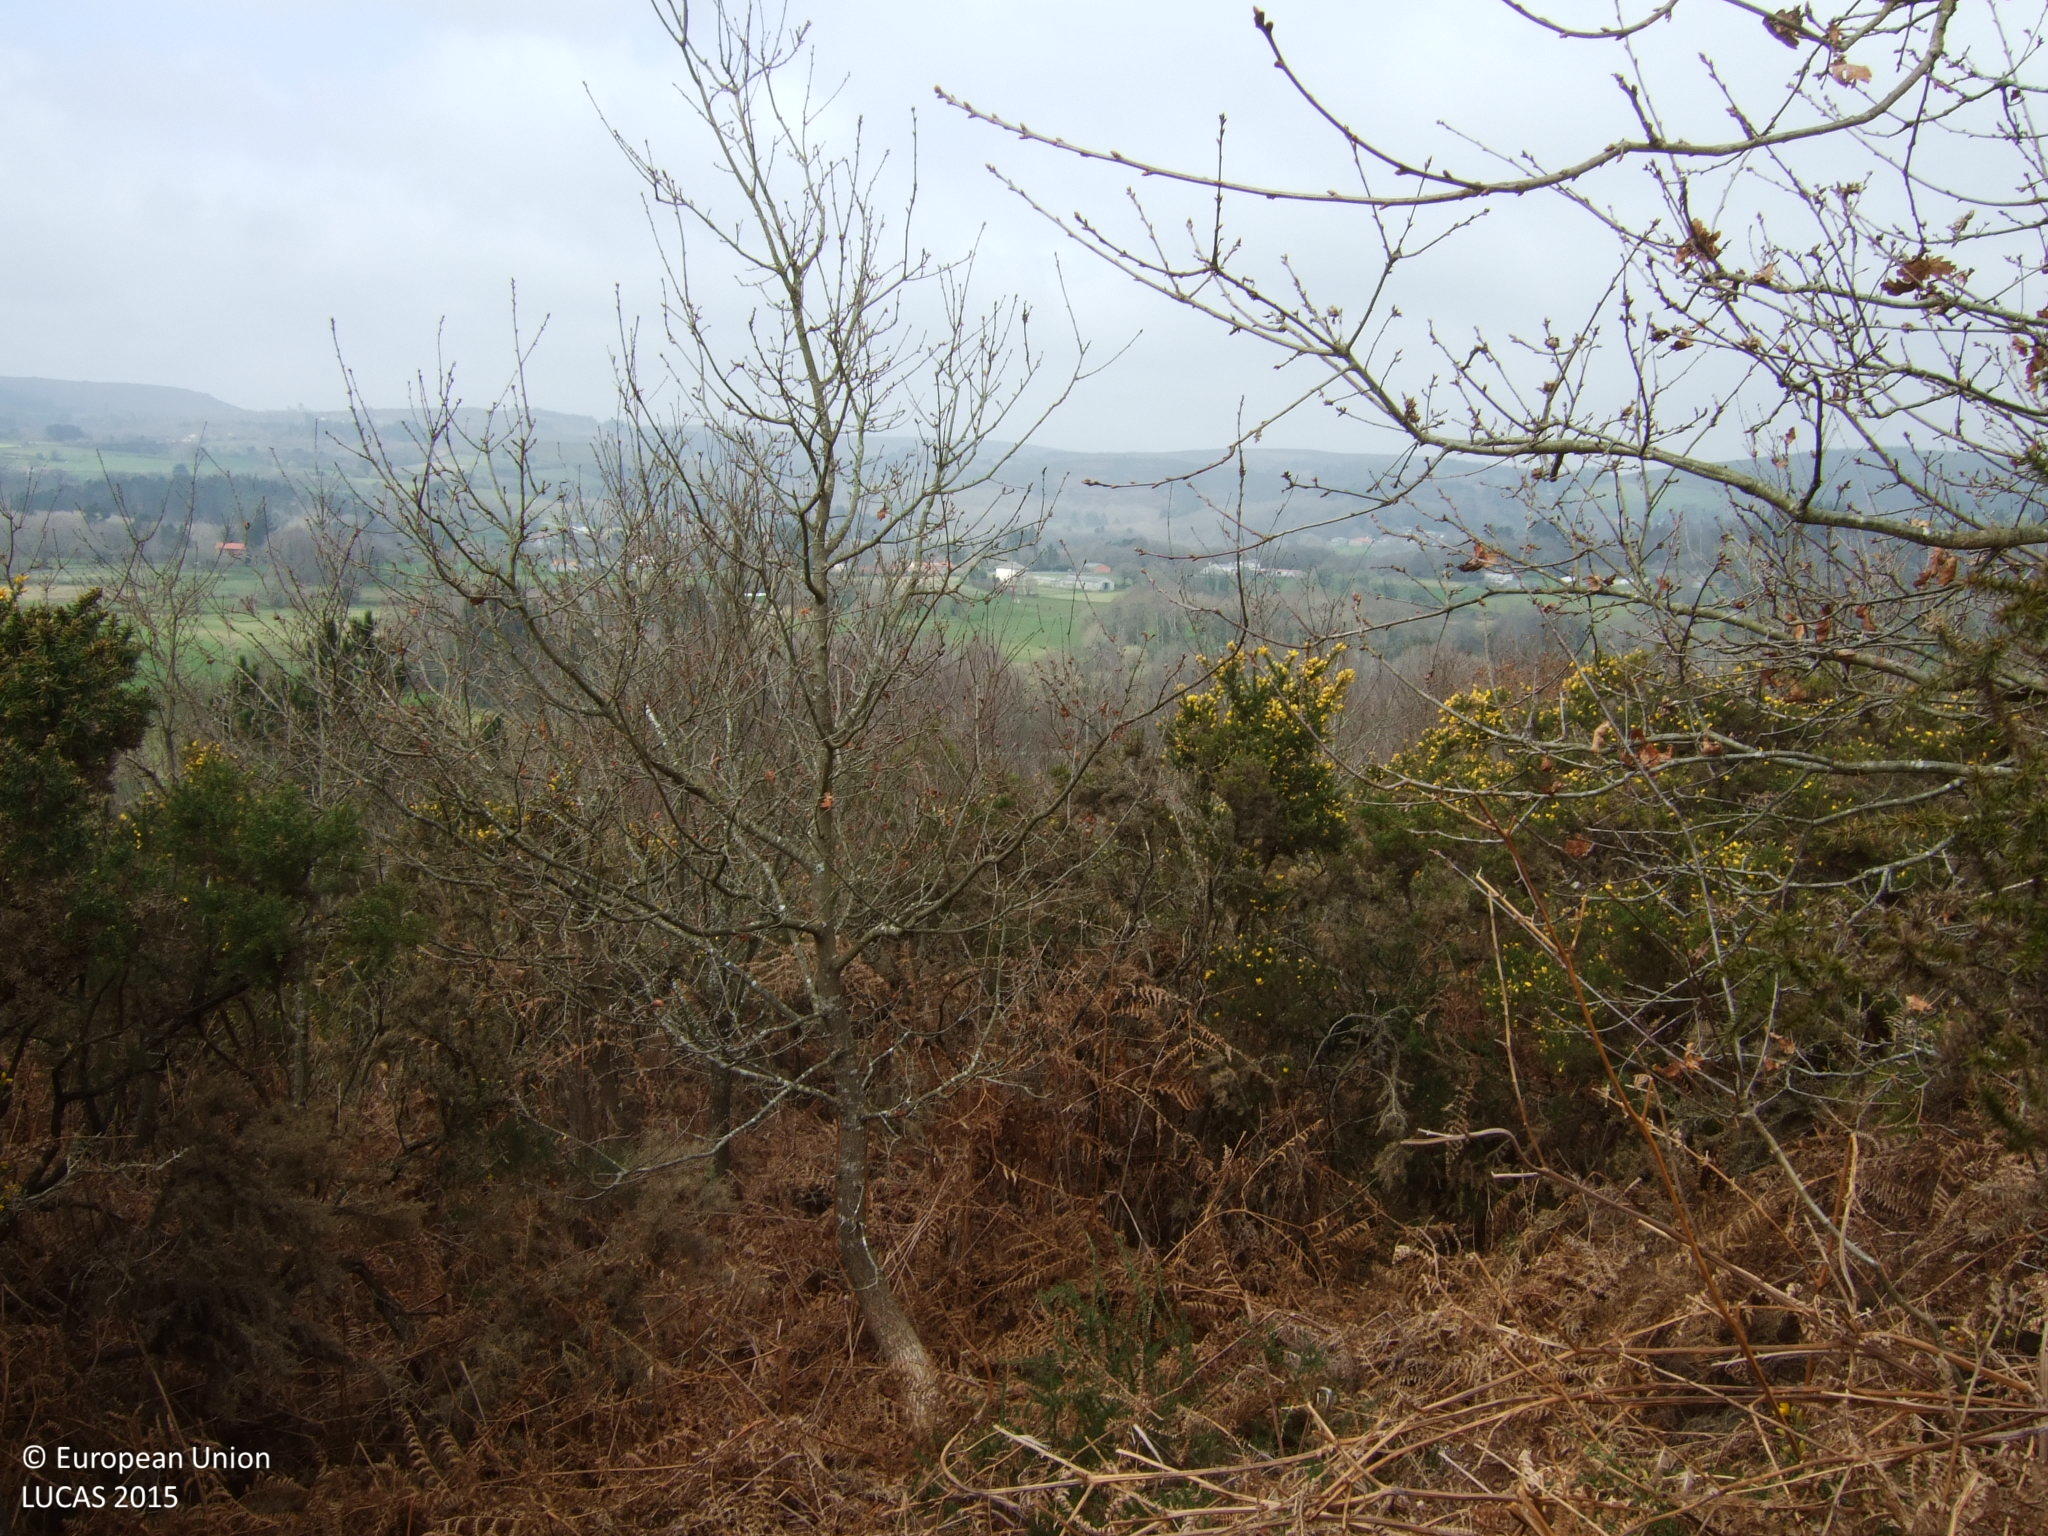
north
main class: Woodland
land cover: Broadleaved woodland
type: acidophilous oak and oak-birch forest
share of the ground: > 75 %
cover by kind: broadleaved forest trees 80 %, shrubs 20 %
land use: Semi-natural and natural areas not in use
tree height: > 5 m
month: March
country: ES
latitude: 42.9323
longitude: -7.8645
